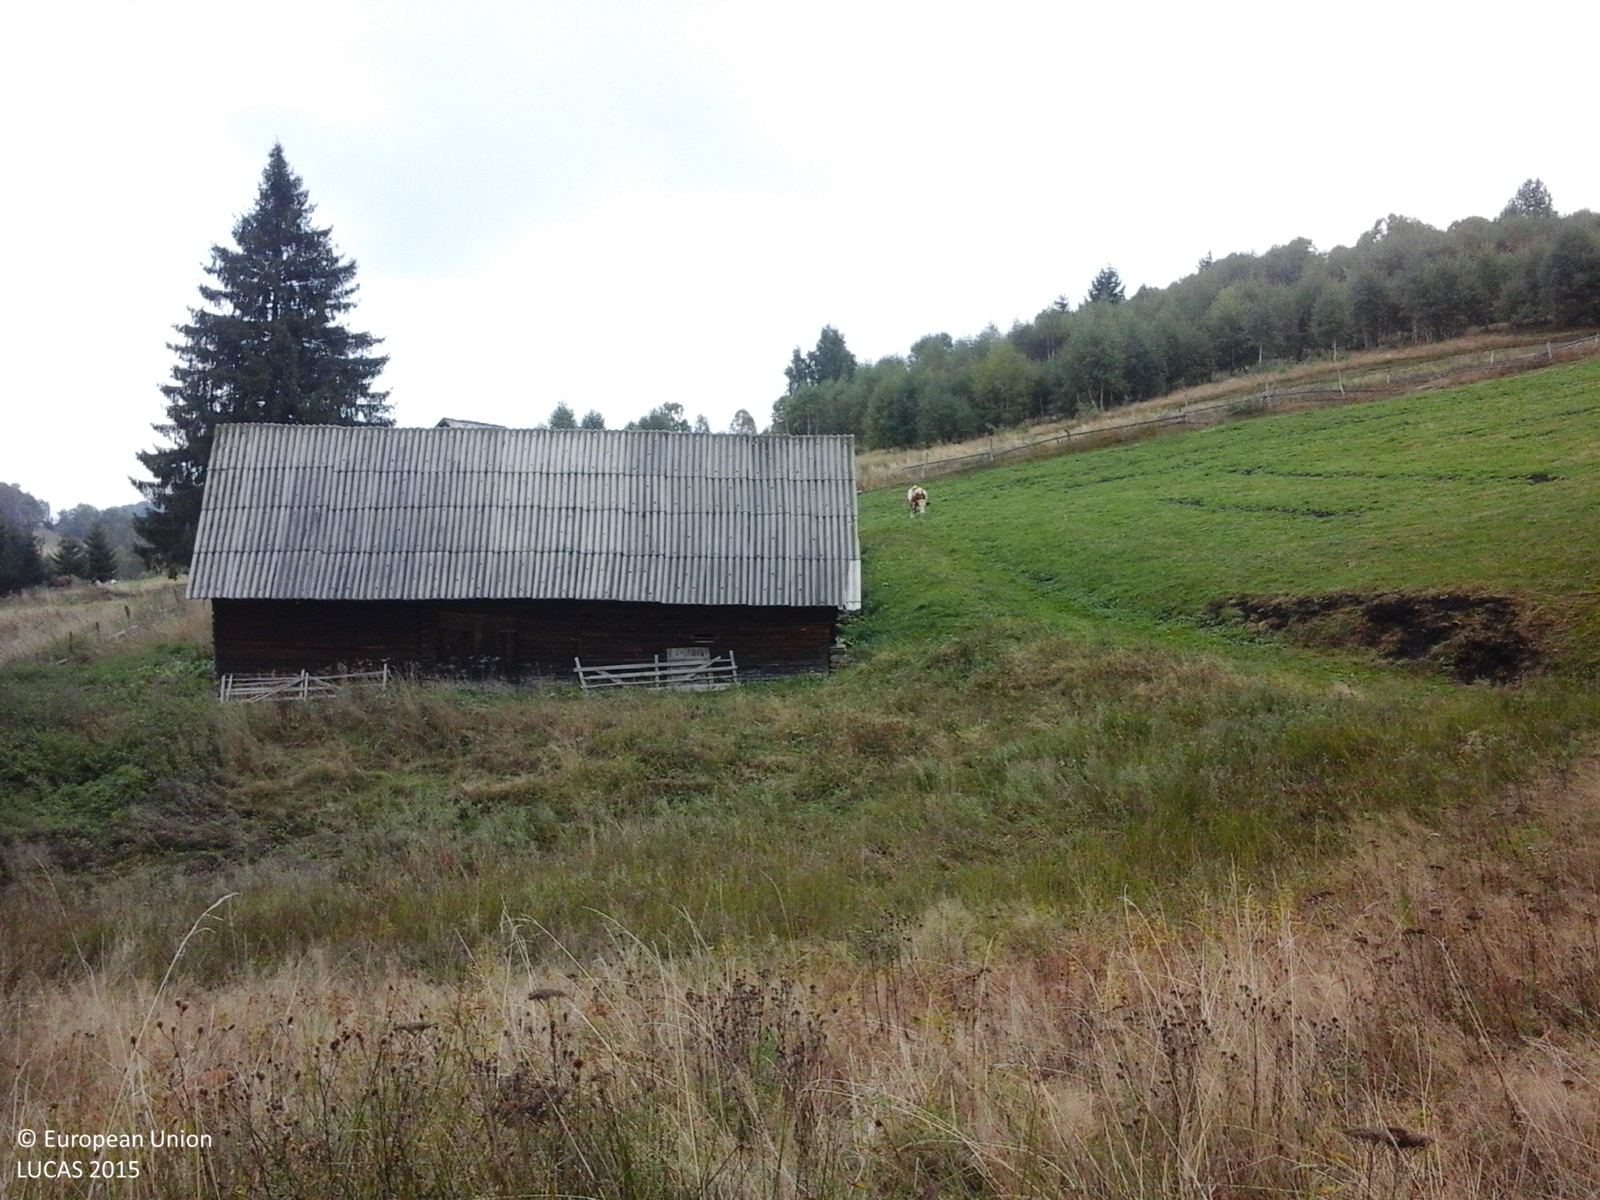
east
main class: Grassland
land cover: Spontaneously vegetated surfaces
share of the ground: > 75 %
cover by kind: herbaceous plants 100 %
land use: Forestry
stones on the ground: < 10 %
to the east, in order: Spontaneously vegetated surfaces; Artificial constructions in urban areas; Grassland without tree/shrub cover; Fences; Grass margins; Tracks; Grass margins; Fences; Spontaneously vegetated surfaces; Grassland with sparse tree/shrub cover; Broadleaved woodland; Grassland without tree/shrub cover; Broadleaved woodland
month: October
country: RO
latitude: 45.7360
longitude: 23.8586
